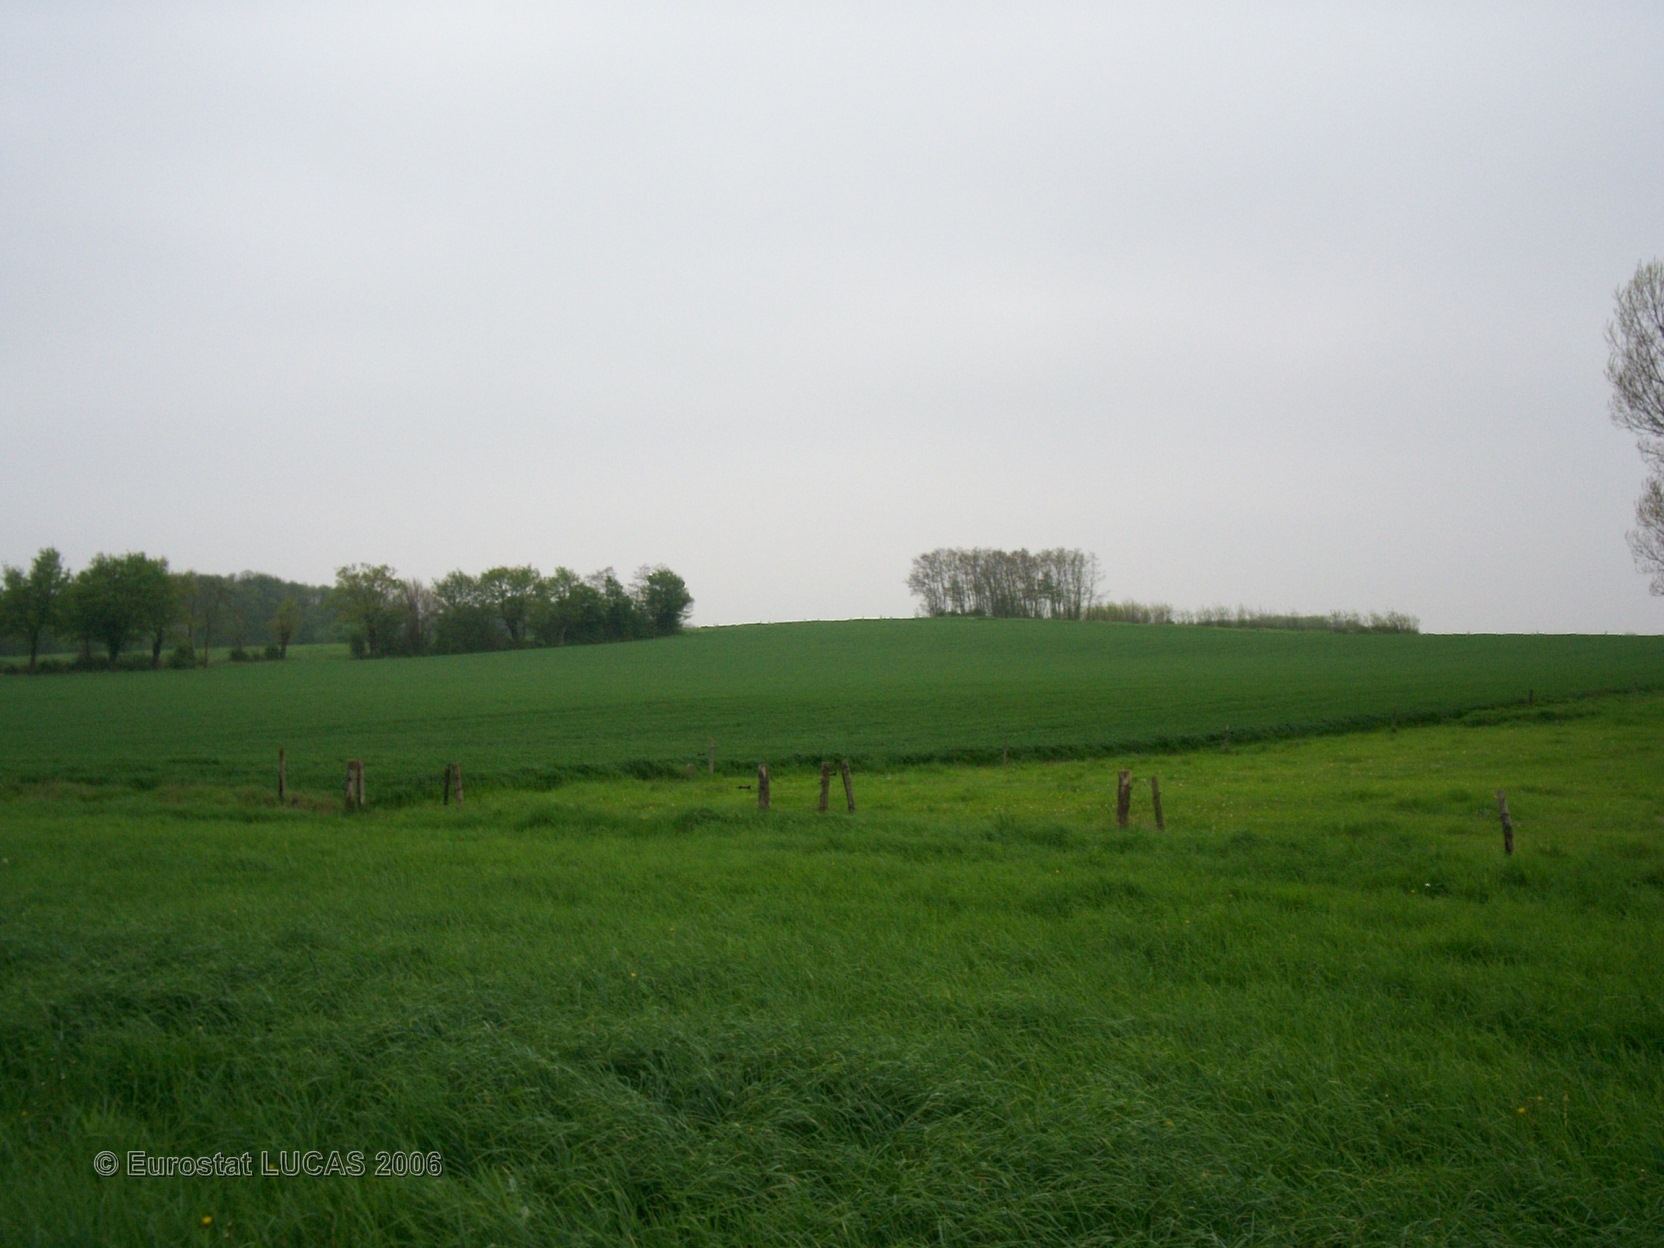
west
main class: Grassland
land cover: Grassland without tree/shrub cover
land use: Agriculture (excluding fallow land and kitchen gardens)
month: April
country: FR
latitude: 46.0837
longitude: 4.8689
